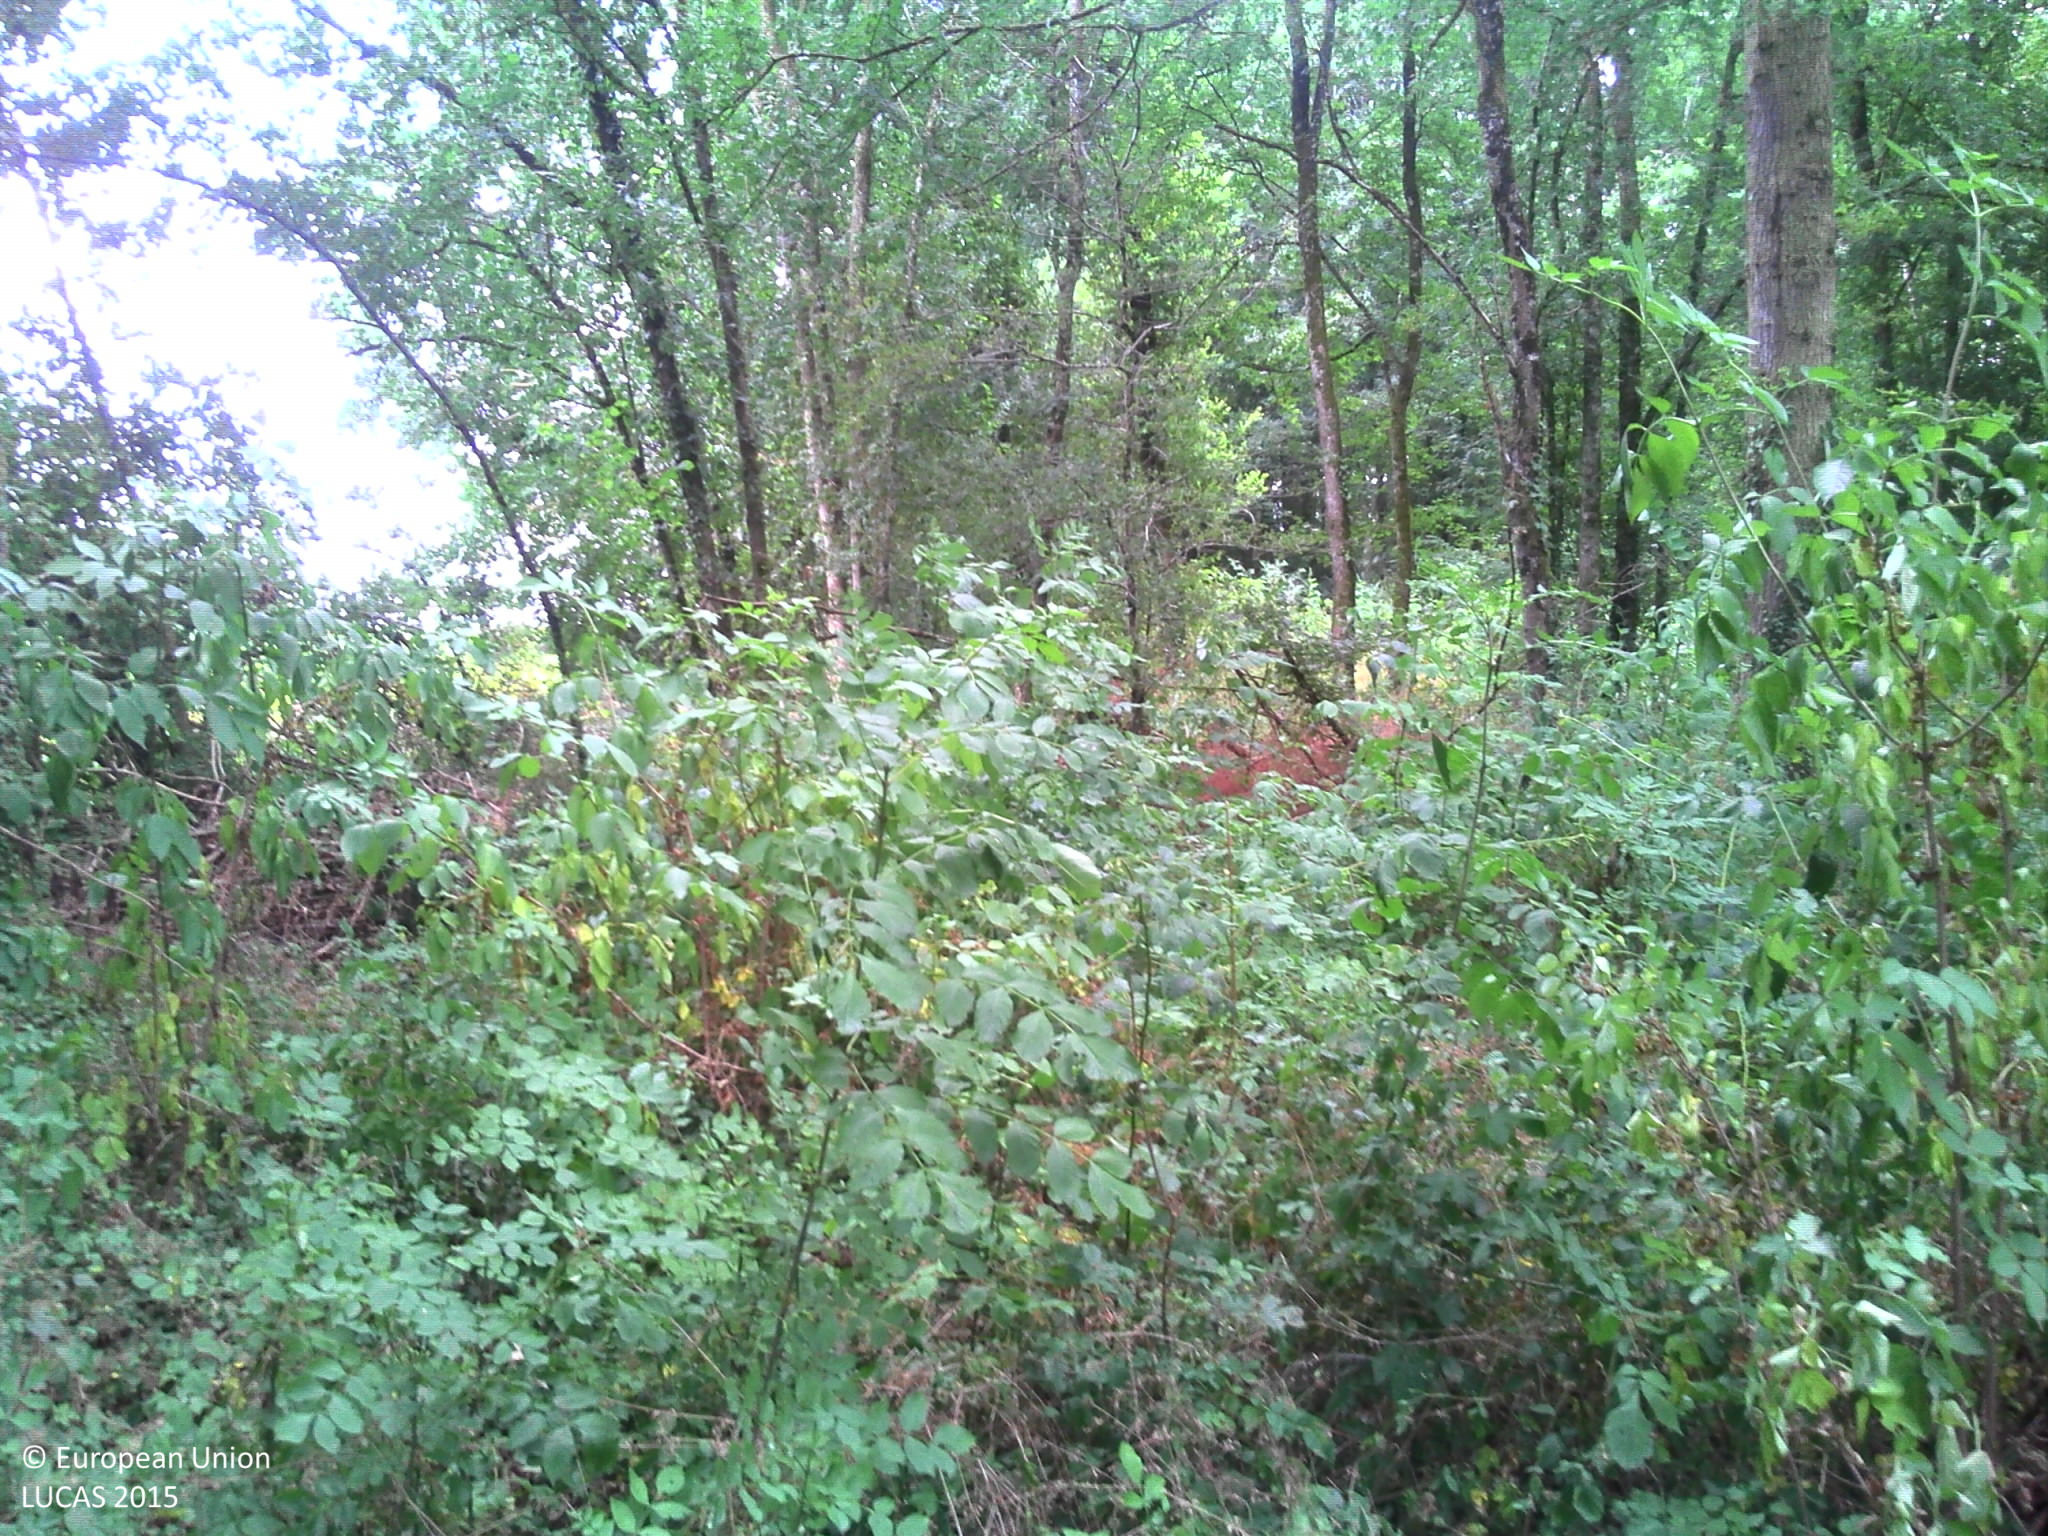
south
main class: Woodland
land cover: Broadleaved woodland
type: mesophytic deciduous forest
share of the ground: > 75 %
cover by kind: broadleaved forest trees 100 %
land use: Forestry
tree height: > 5 m
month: July
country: FR
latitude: 47.9000
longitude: 2.8358
